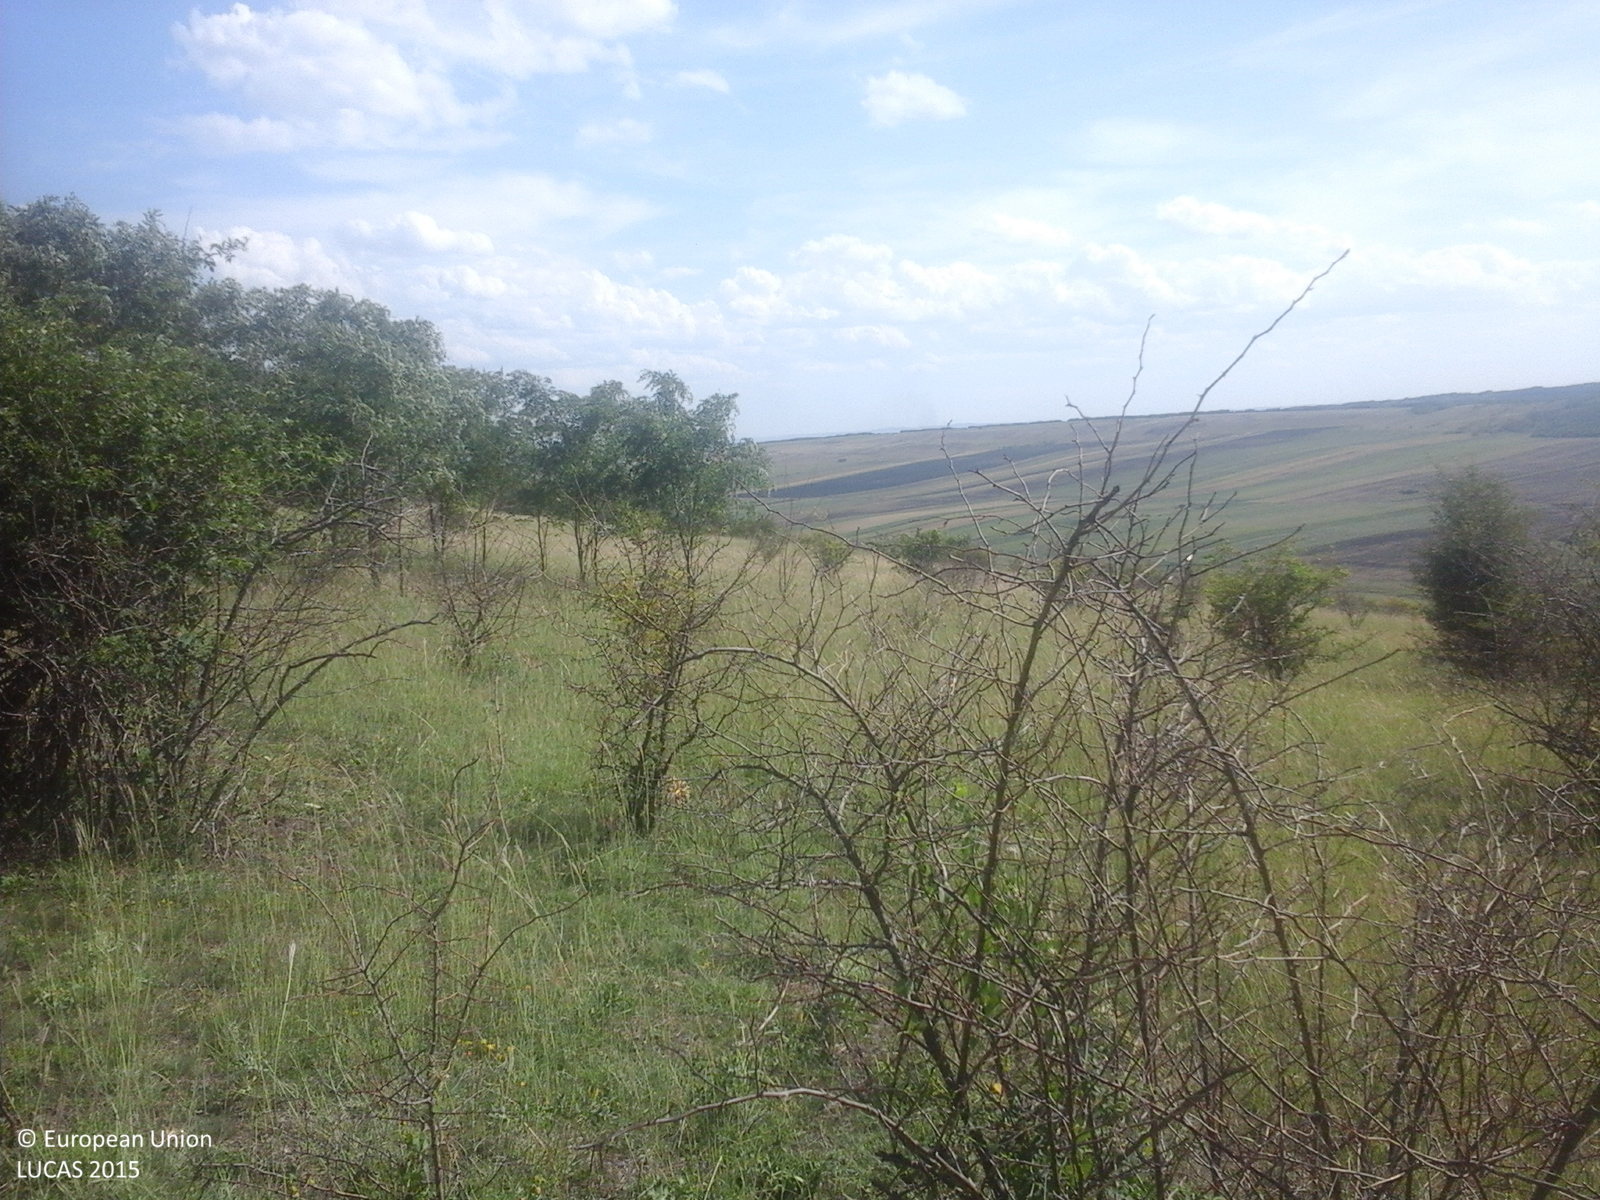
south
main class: Grassland
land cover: Grassland with sparse tree/shrub cover
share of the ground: > 75 %
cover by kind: herbaceous plants 85 %, shrubs 10 %, broadleaved forest trees 5 %
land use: Agriculture (excluding fallow land and kitchen gardens)
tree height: < 5 m
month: July
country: RO
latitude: 46.4879
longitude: 27.9864
